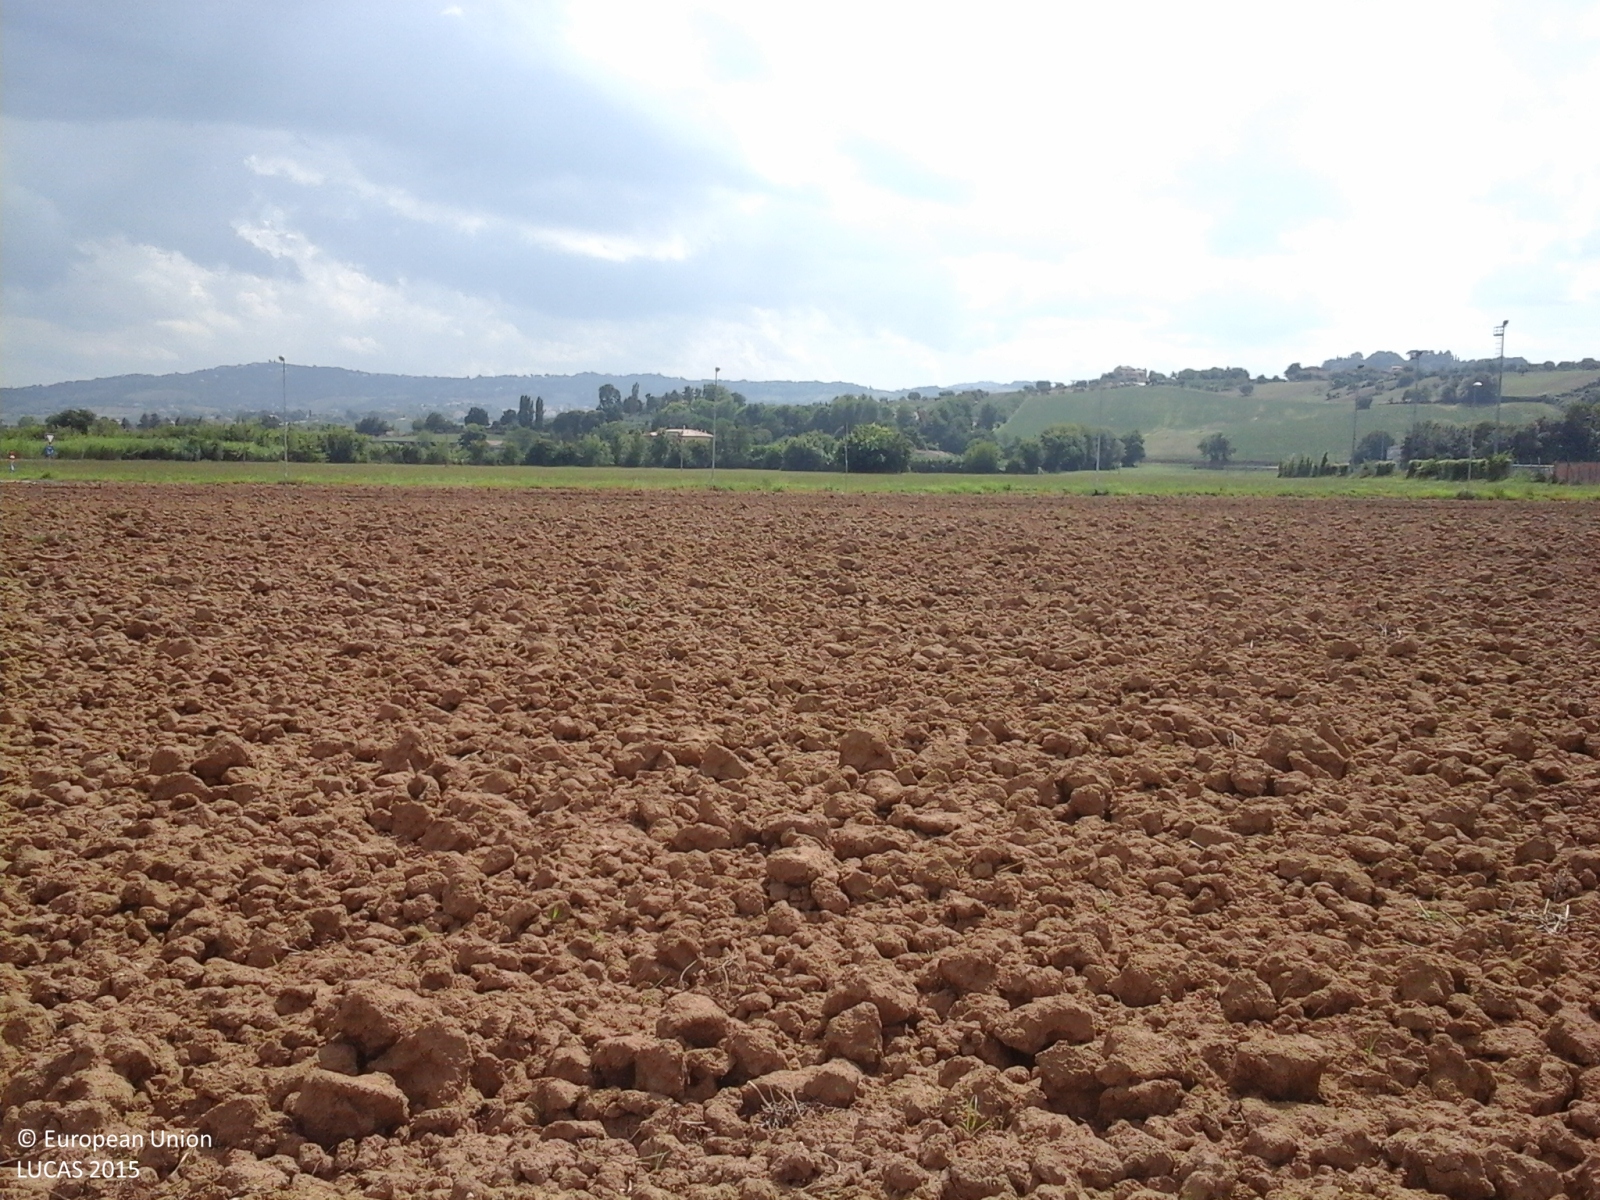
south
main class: Cropland
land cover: Durum wheat
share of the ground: < 10 %
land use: Agriculture (excluding fallow land and kitchen gardens)
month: August
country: IT
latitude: 43.4897
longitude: 13.1700
